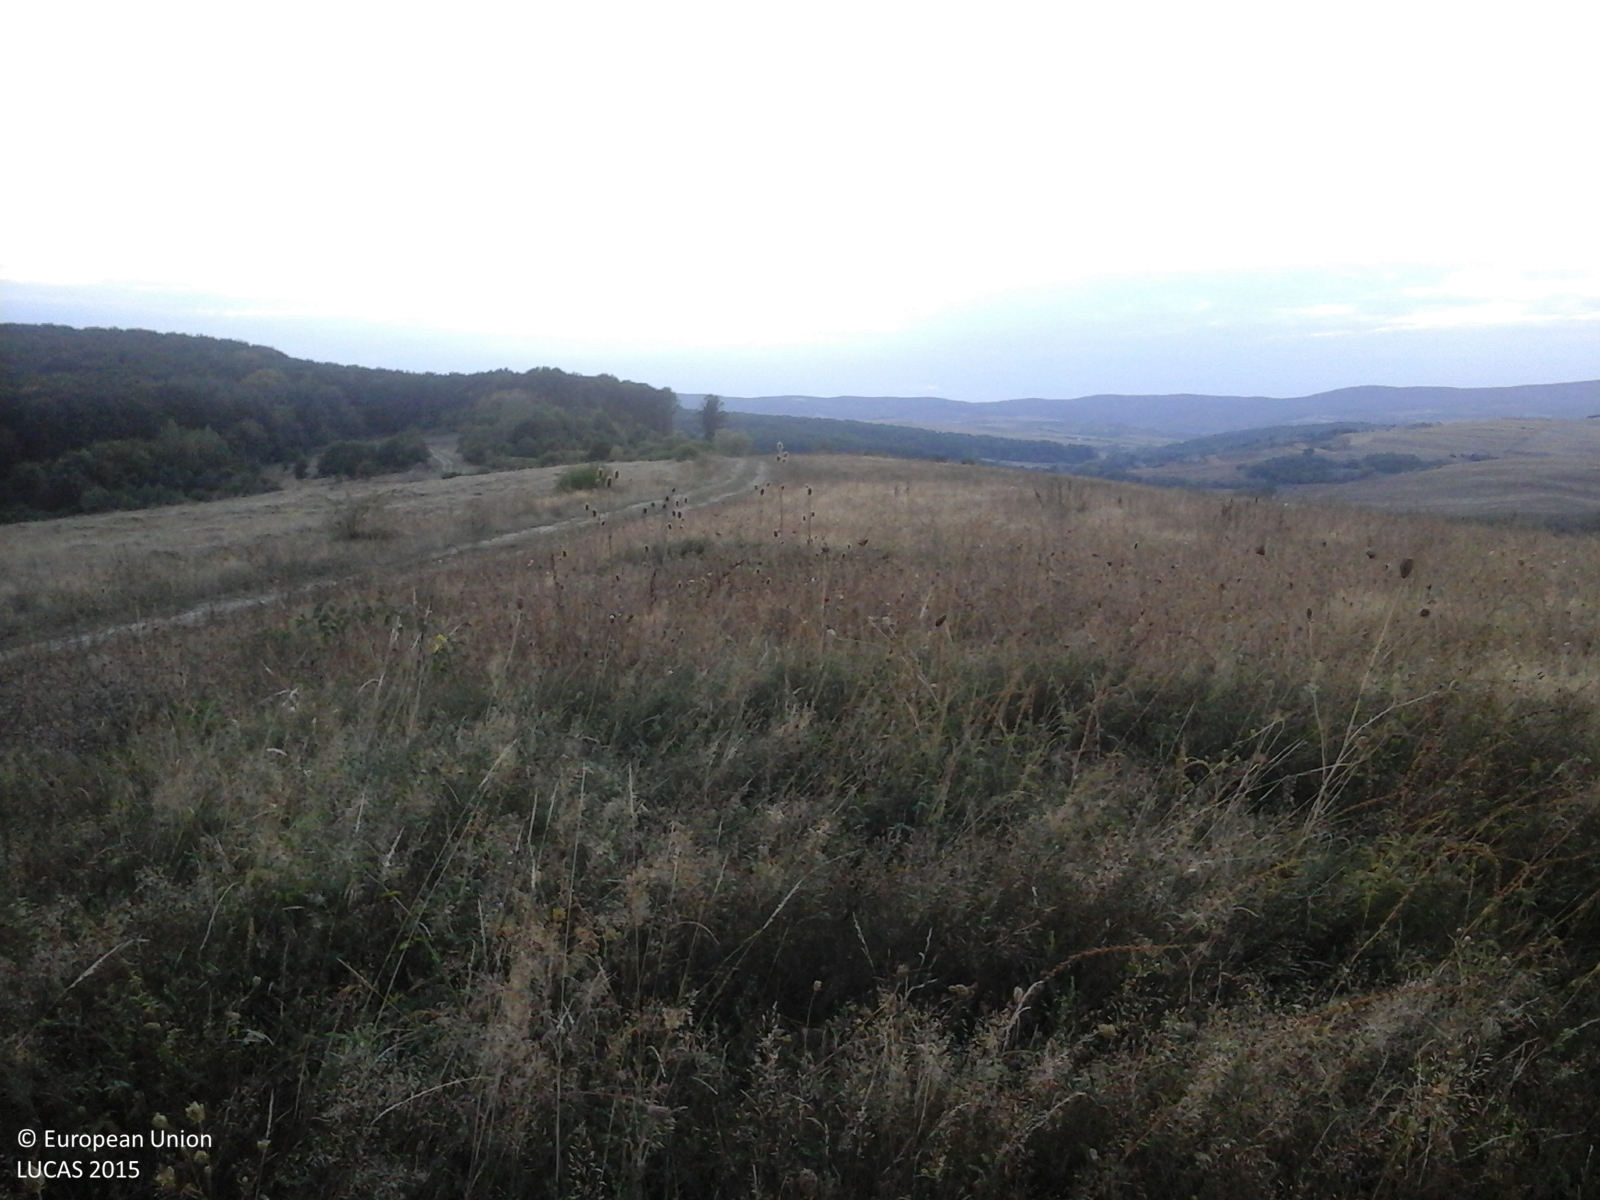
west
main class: Grassland
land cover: Spontaneously vegetated surfaces
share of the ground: > 75 %
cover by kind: herbaceous plants 100 %
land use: Fallow land
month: September
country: RO
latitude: 47.5020
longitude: 23.1711
